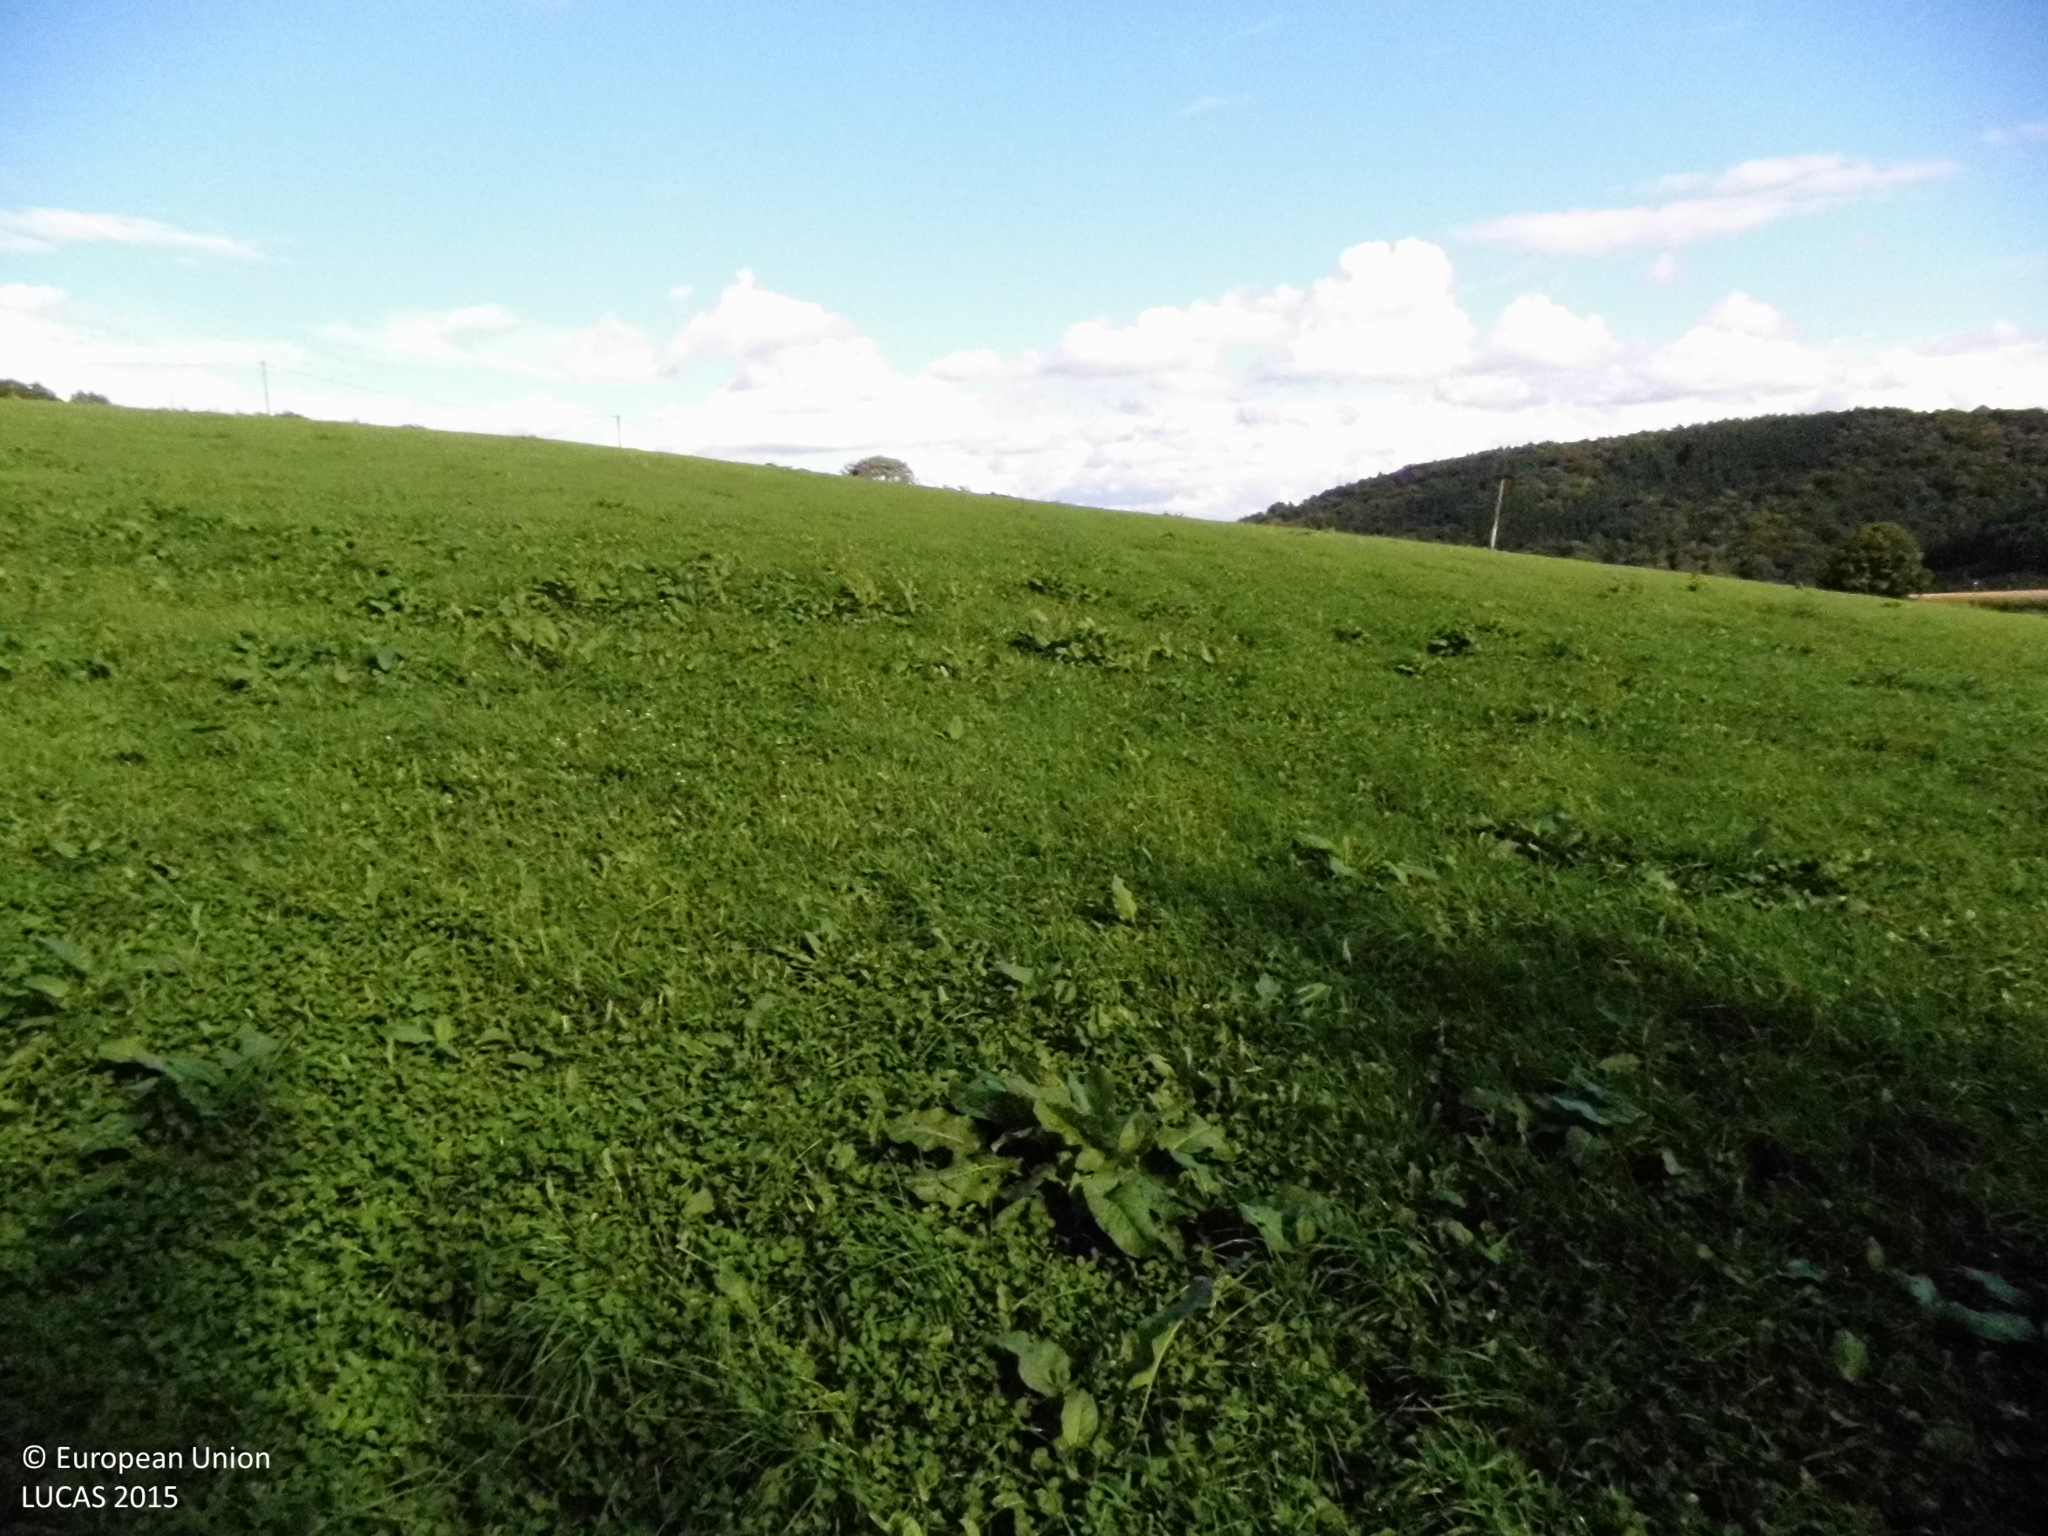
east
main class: Grassland
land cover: Grassland without tree/shrub cover
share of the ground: > 75 %
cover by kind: herbaceous plants 100 %
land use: Agriculture (excluding fallow land and kitchen gardens)
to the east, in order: Grassland without tree/shrub cover; Fences; Paved roads, cycling and walking lanes; Electric lines; Shrubland with sparse tree cover; Fences; Grassland without tree/shrub cover
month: September
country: DE
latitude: 51.0725
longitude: 7.4170
